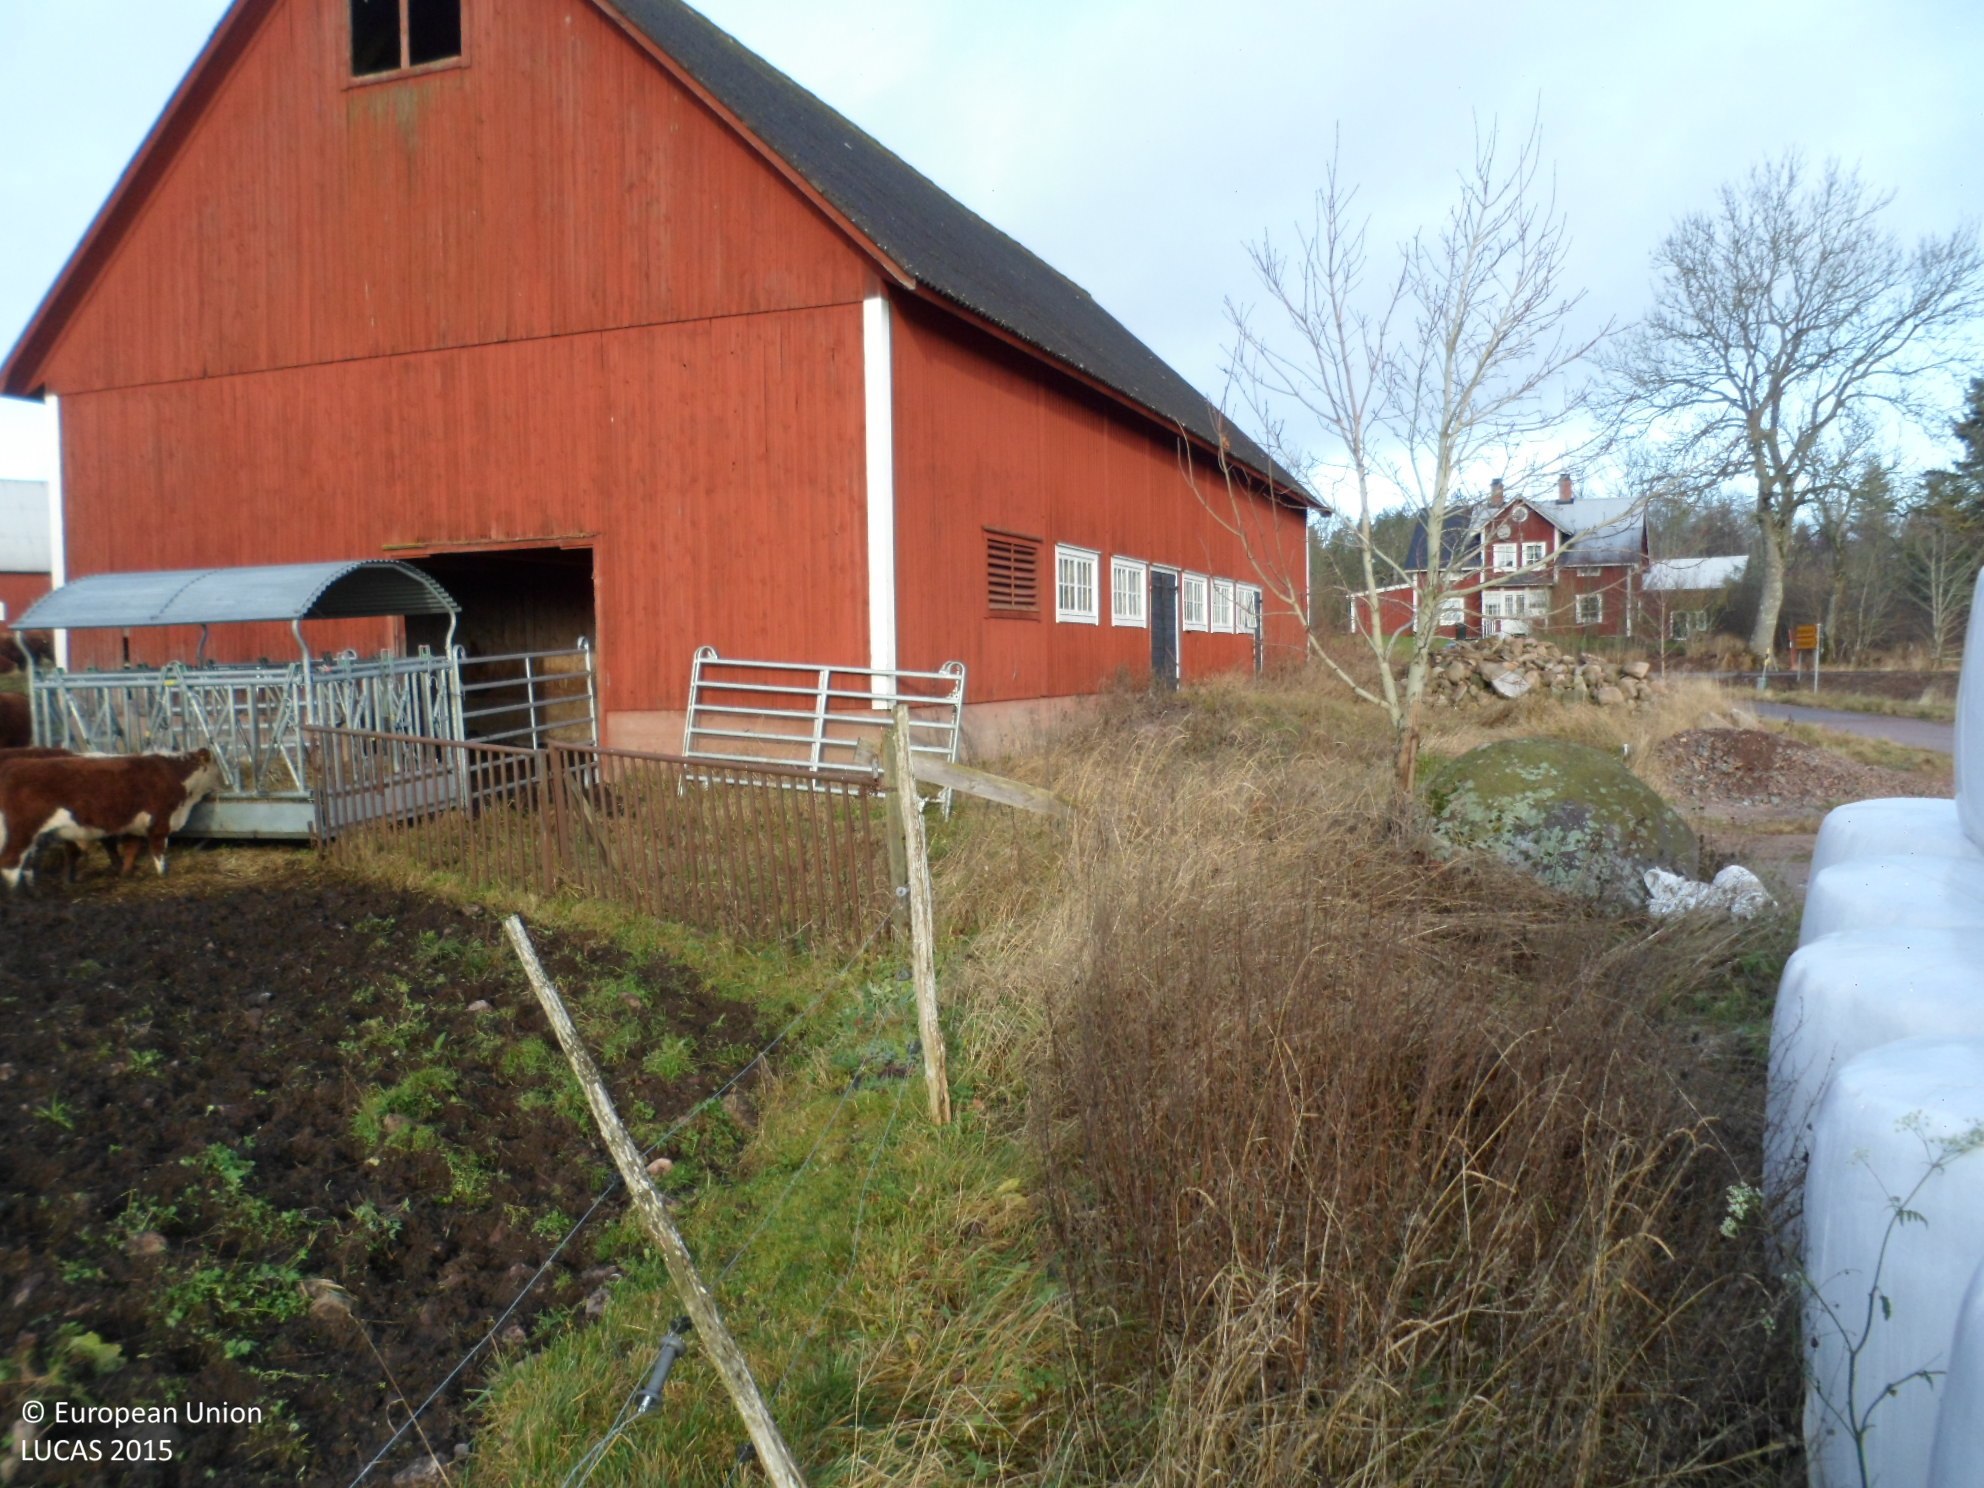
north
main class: Grassland
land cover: Grassland without tree/shrub cover
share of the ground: > 75 %
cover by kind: herbaceous plants 100 %
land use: Agriculture (excluding fallow land and kitchen gardens)
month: November
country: SE
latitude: 57.7275
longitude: 15.5208
